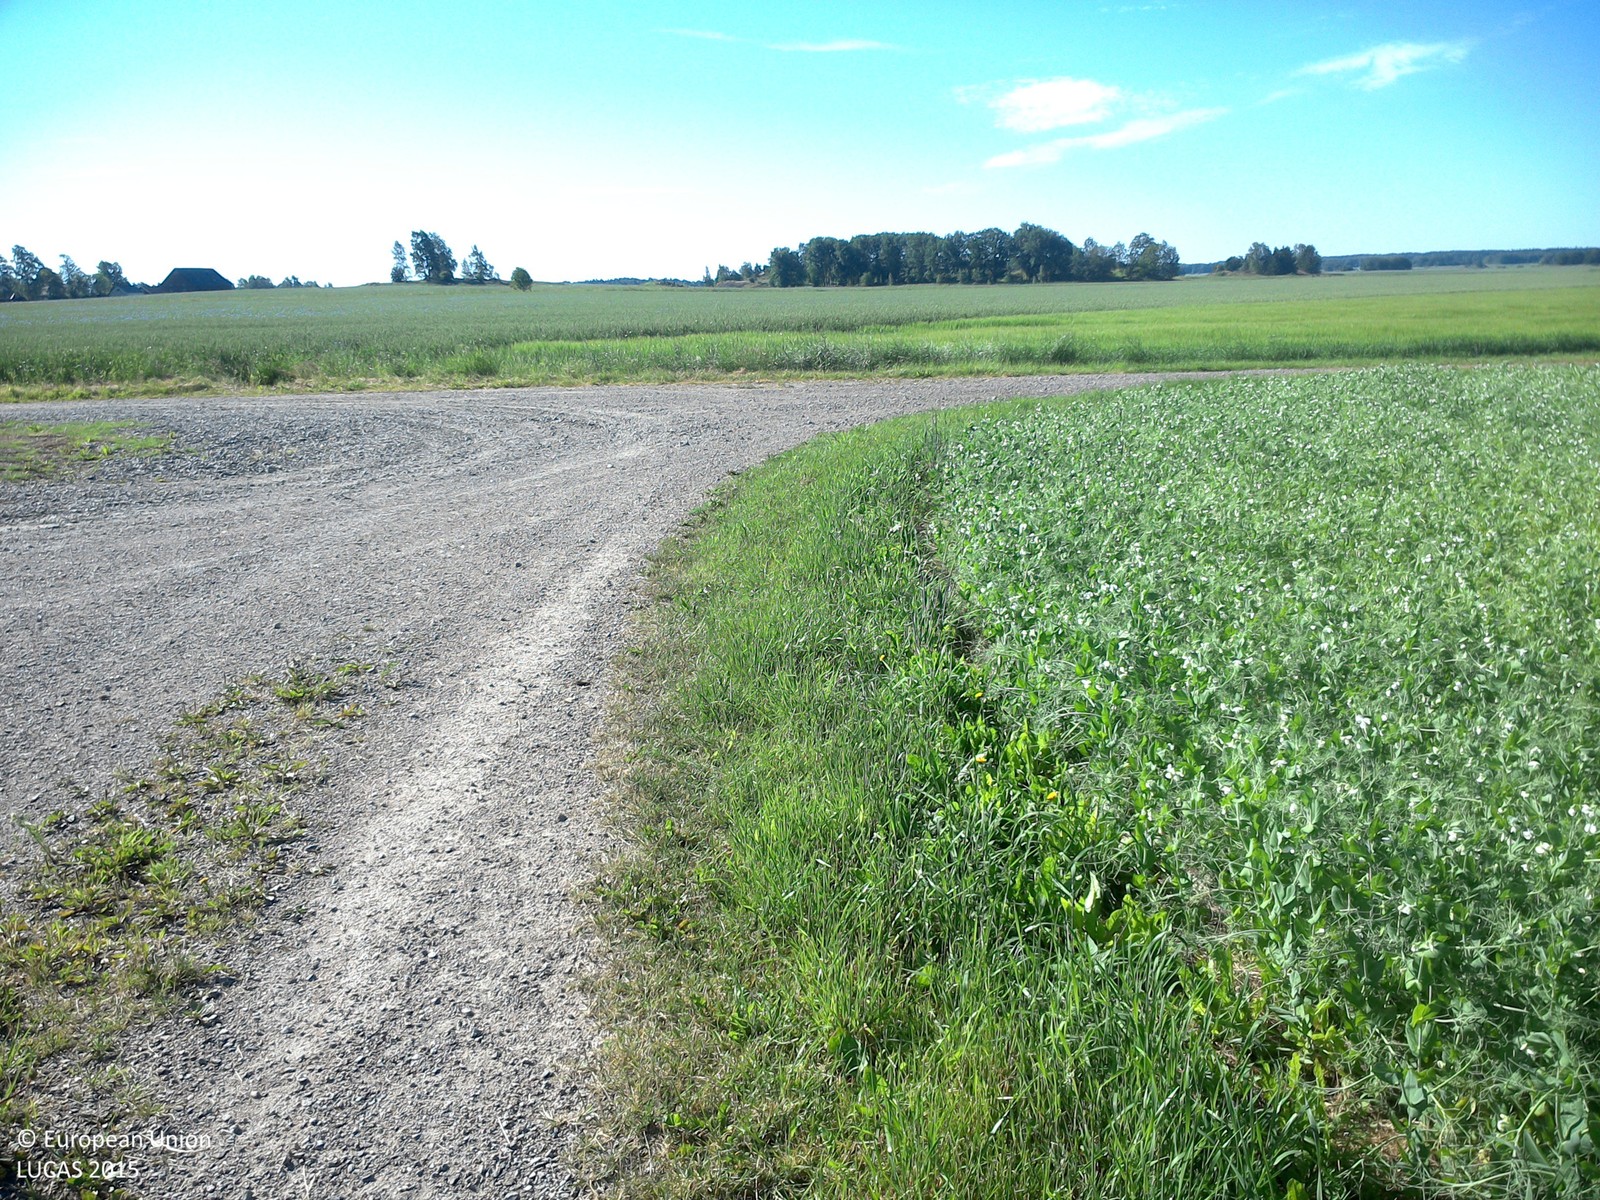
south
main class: Cropland
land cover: Dry pulses
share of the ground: > 75 %
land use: Agriculture (excluding fallow land and kitchen gardens)
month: July
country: SE
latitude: 58.4042
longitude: 15.2820
